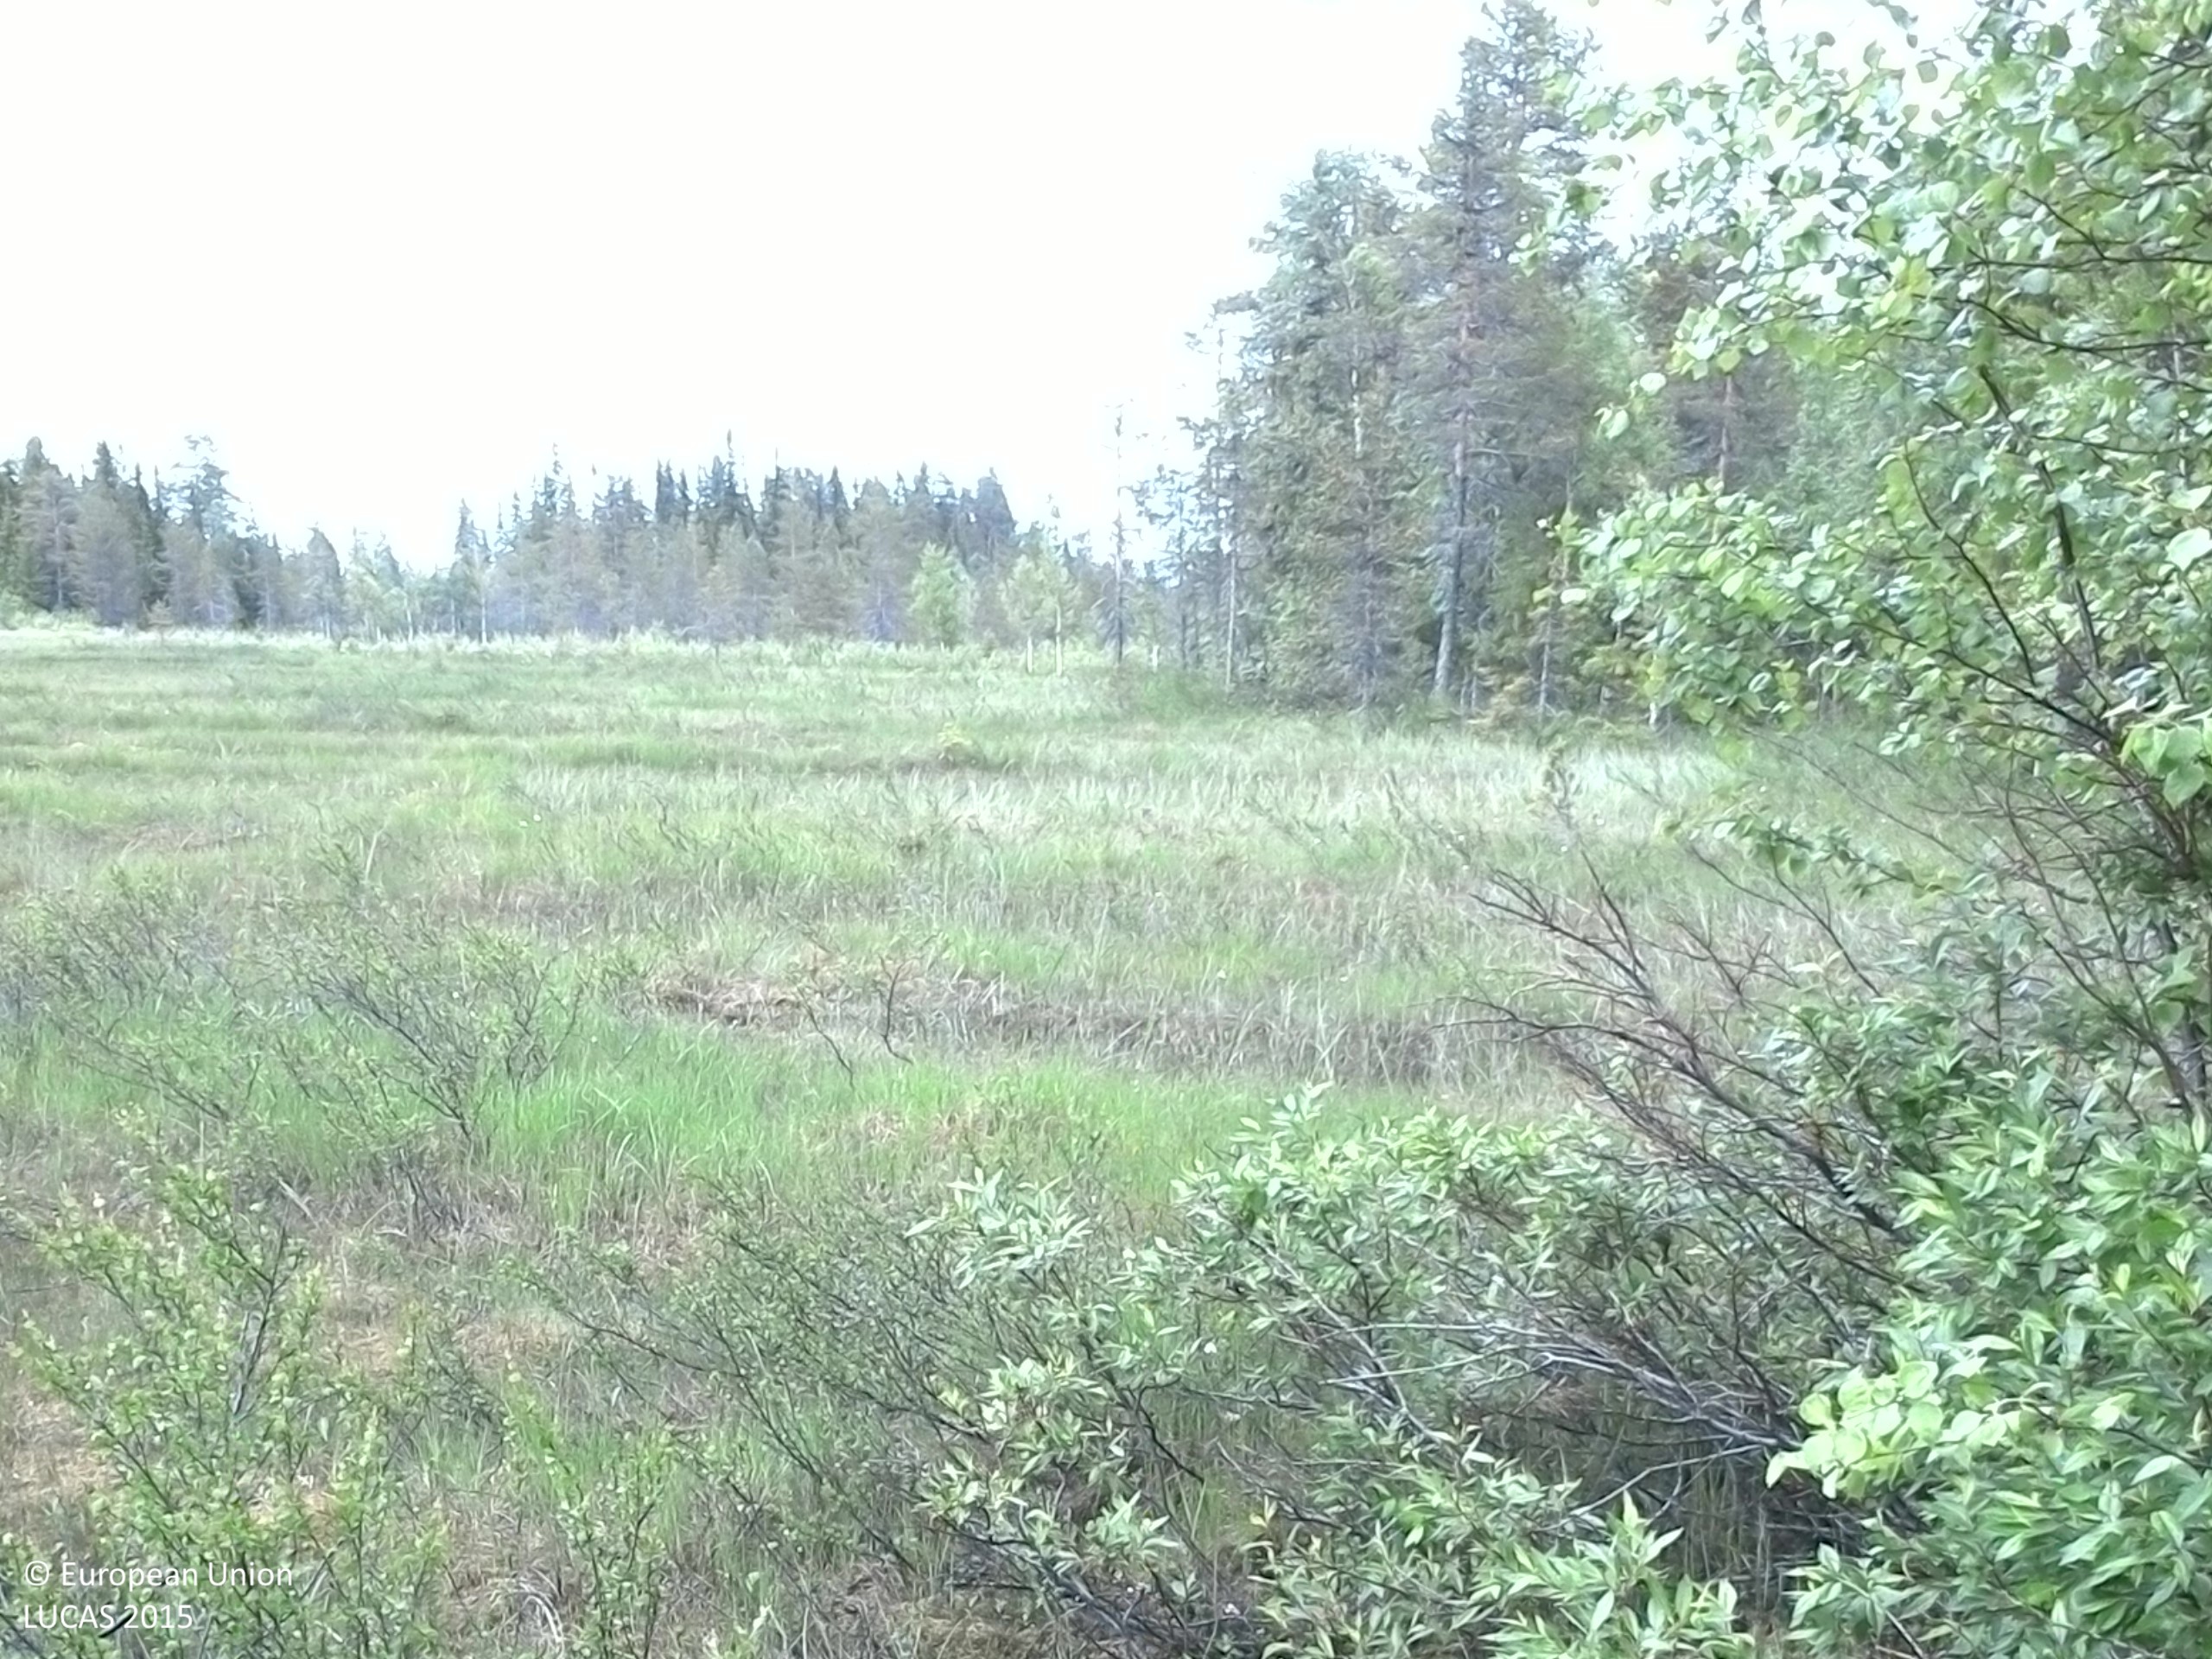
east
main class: Shrubland
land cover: Shrubland with sparse tree cover
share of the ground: 50 - 75 %
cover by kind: shrubs 70 %, herbaceous plants 15 %, lichens and mosses 10 %, broadleaved forest trees 5 %
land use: Semi-natural and natural areas not in use
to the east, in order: Shrubland with sparse tree cover; Peatbogs; Ditches and canals; Shruby margins; Paved roads, cycling and walking lanes; Shruby margins; Shrubland with sparse tree cover; Broadleaved woodland; Shrubland with sparse tree cover; Peatbogs
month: July
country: SE
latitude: 64.3755
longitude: 16.4554
